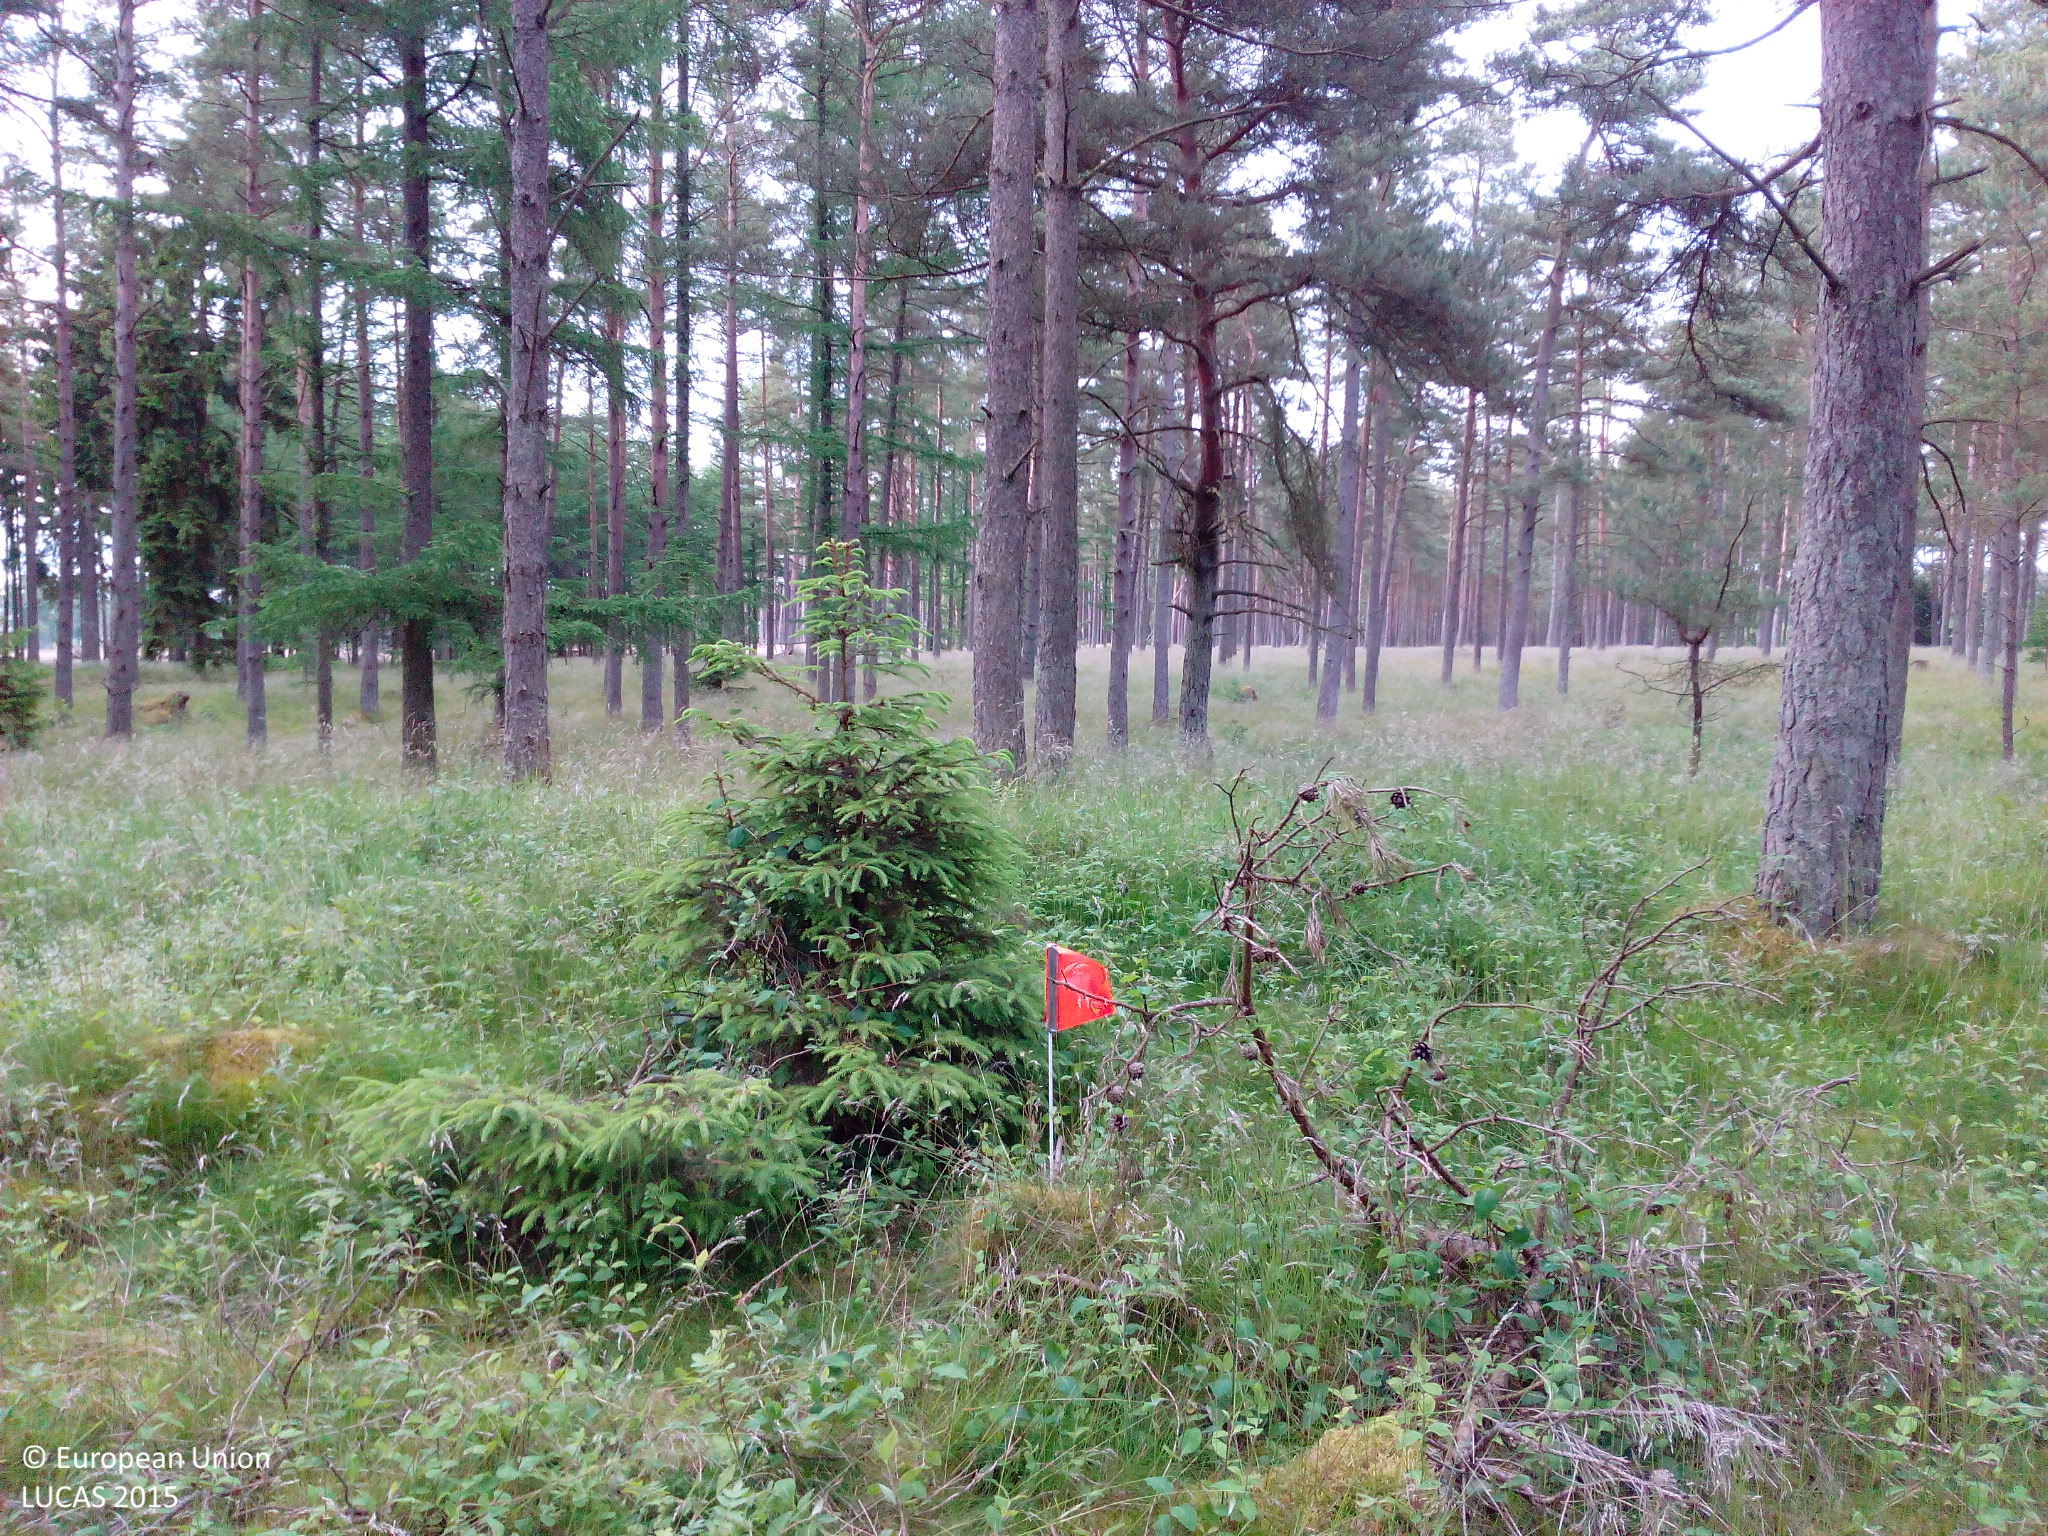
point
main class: Woodland
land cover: Pine dominated coniferous woodland
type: hemiboreal forest and nemoral coniferous forest and mixed broadleaved-coniferous forest
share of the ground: 25 - 50 %
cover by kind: herbaceous plants 50 %, coniferous forest trees 30 %, lichens and mosses 20 %
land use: Forestry
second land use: Amenities, museums, leisure
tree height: > 5 m
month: June
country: DK
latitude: 56.2939
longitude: 10.6616
